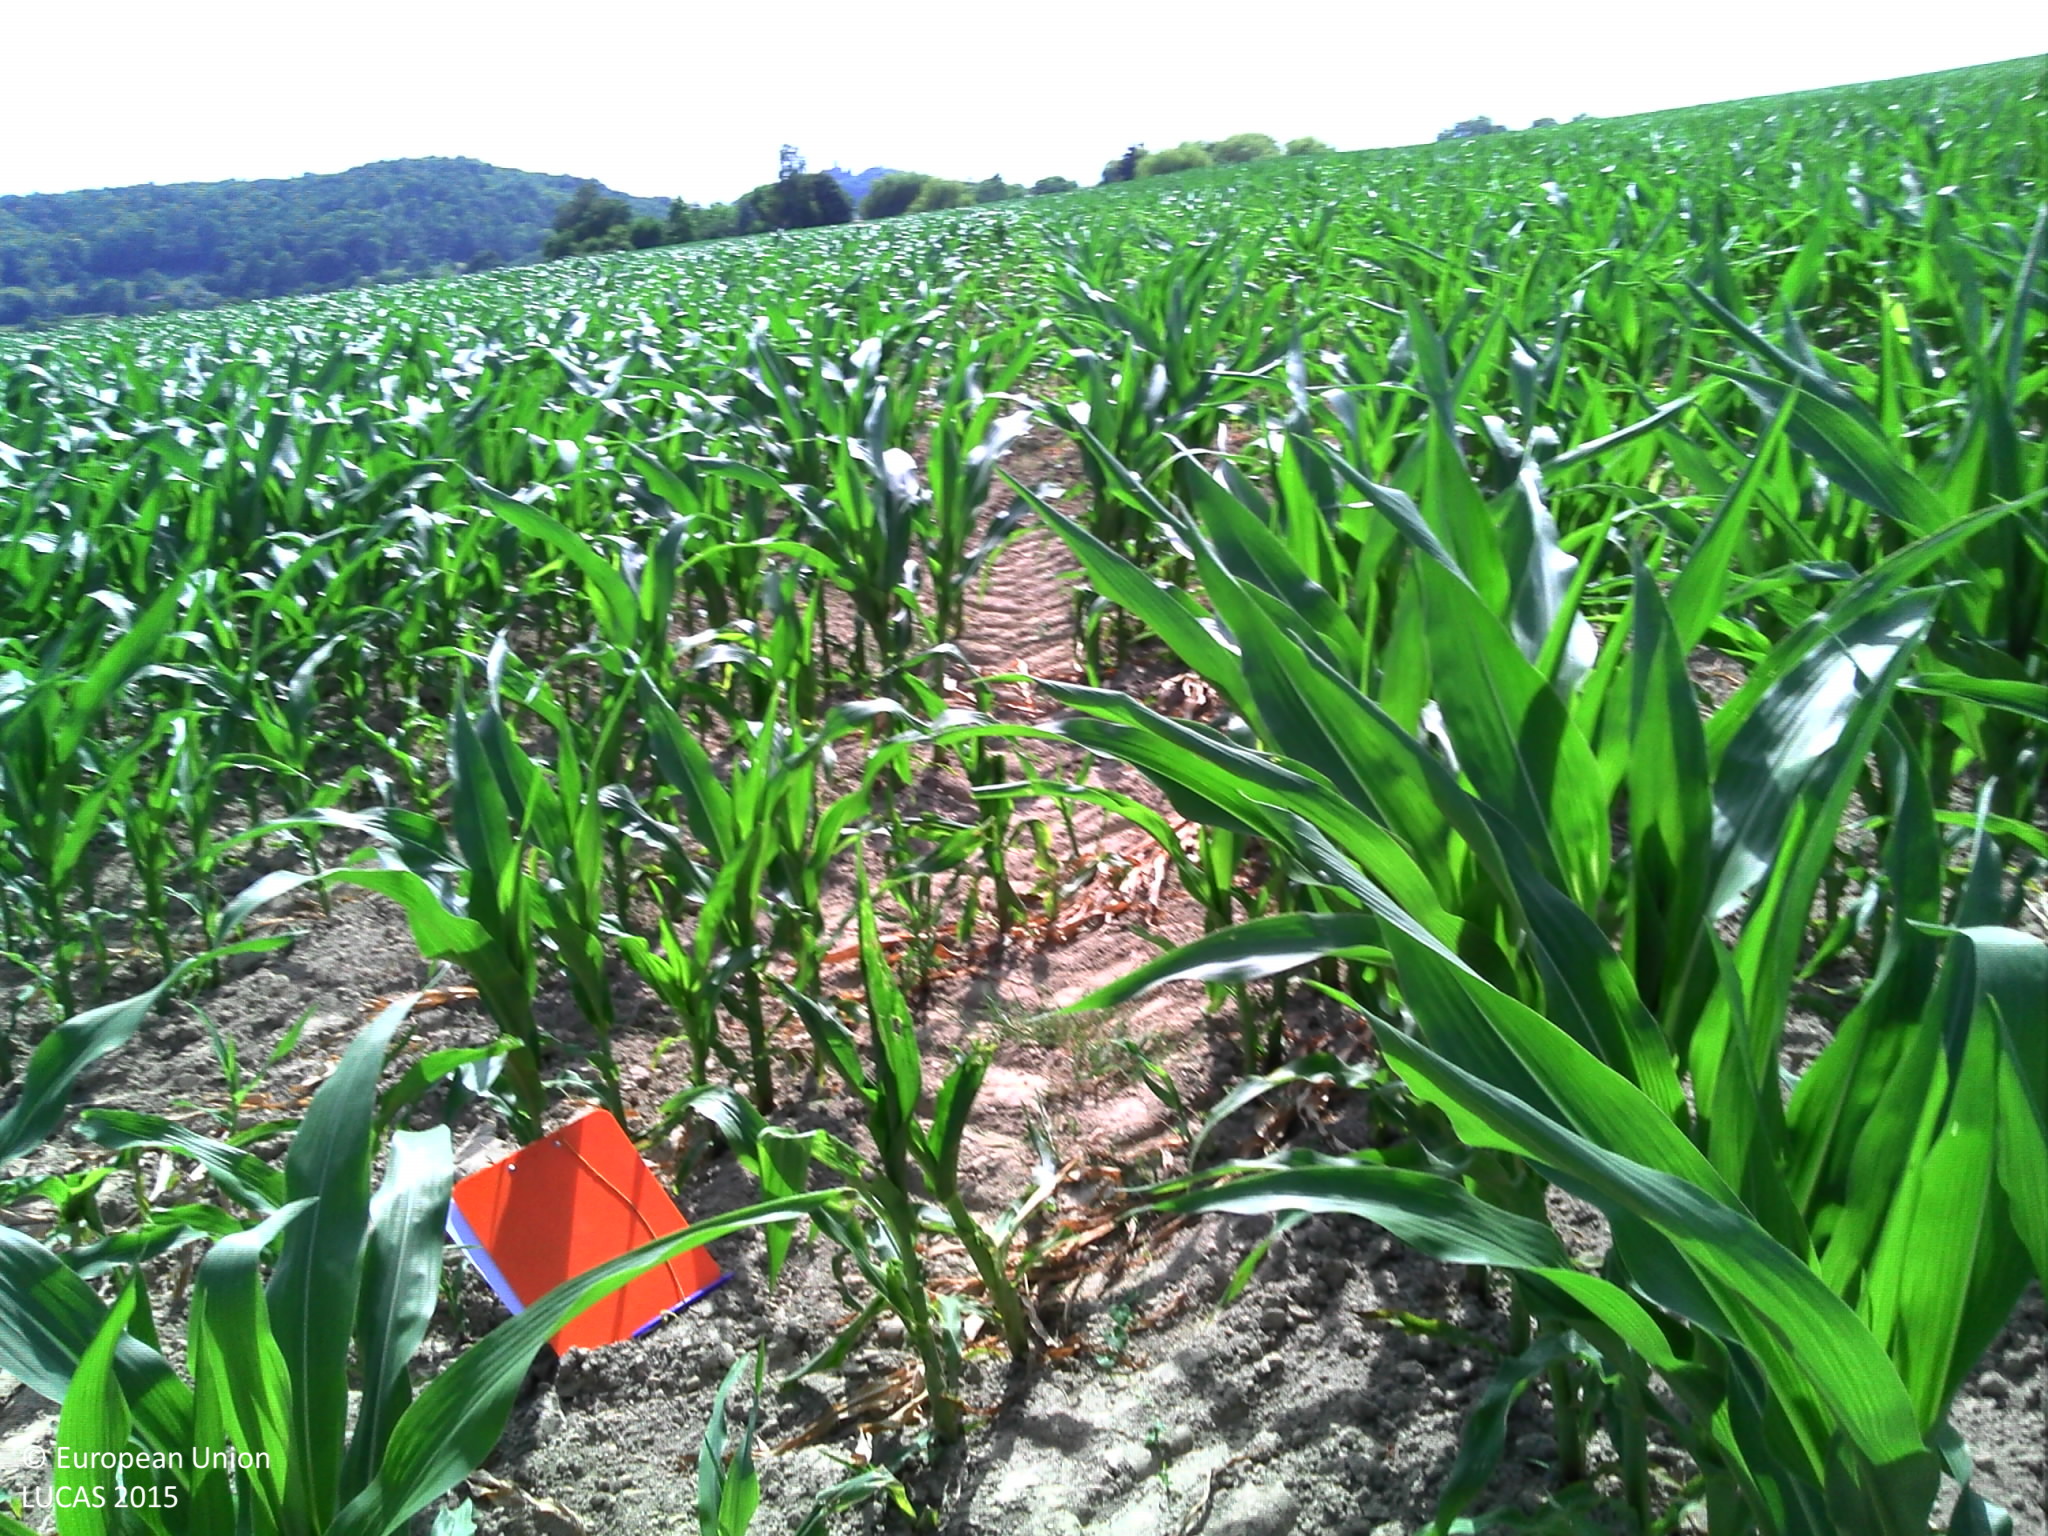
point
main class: Cropland
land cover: Maize
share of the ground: 50 - 75 %
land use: Agriculture (excluding fallow land and kitchen gardens)
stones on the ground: < 10 %
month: July
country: FR
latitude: 43.0948
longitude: 0.8745
